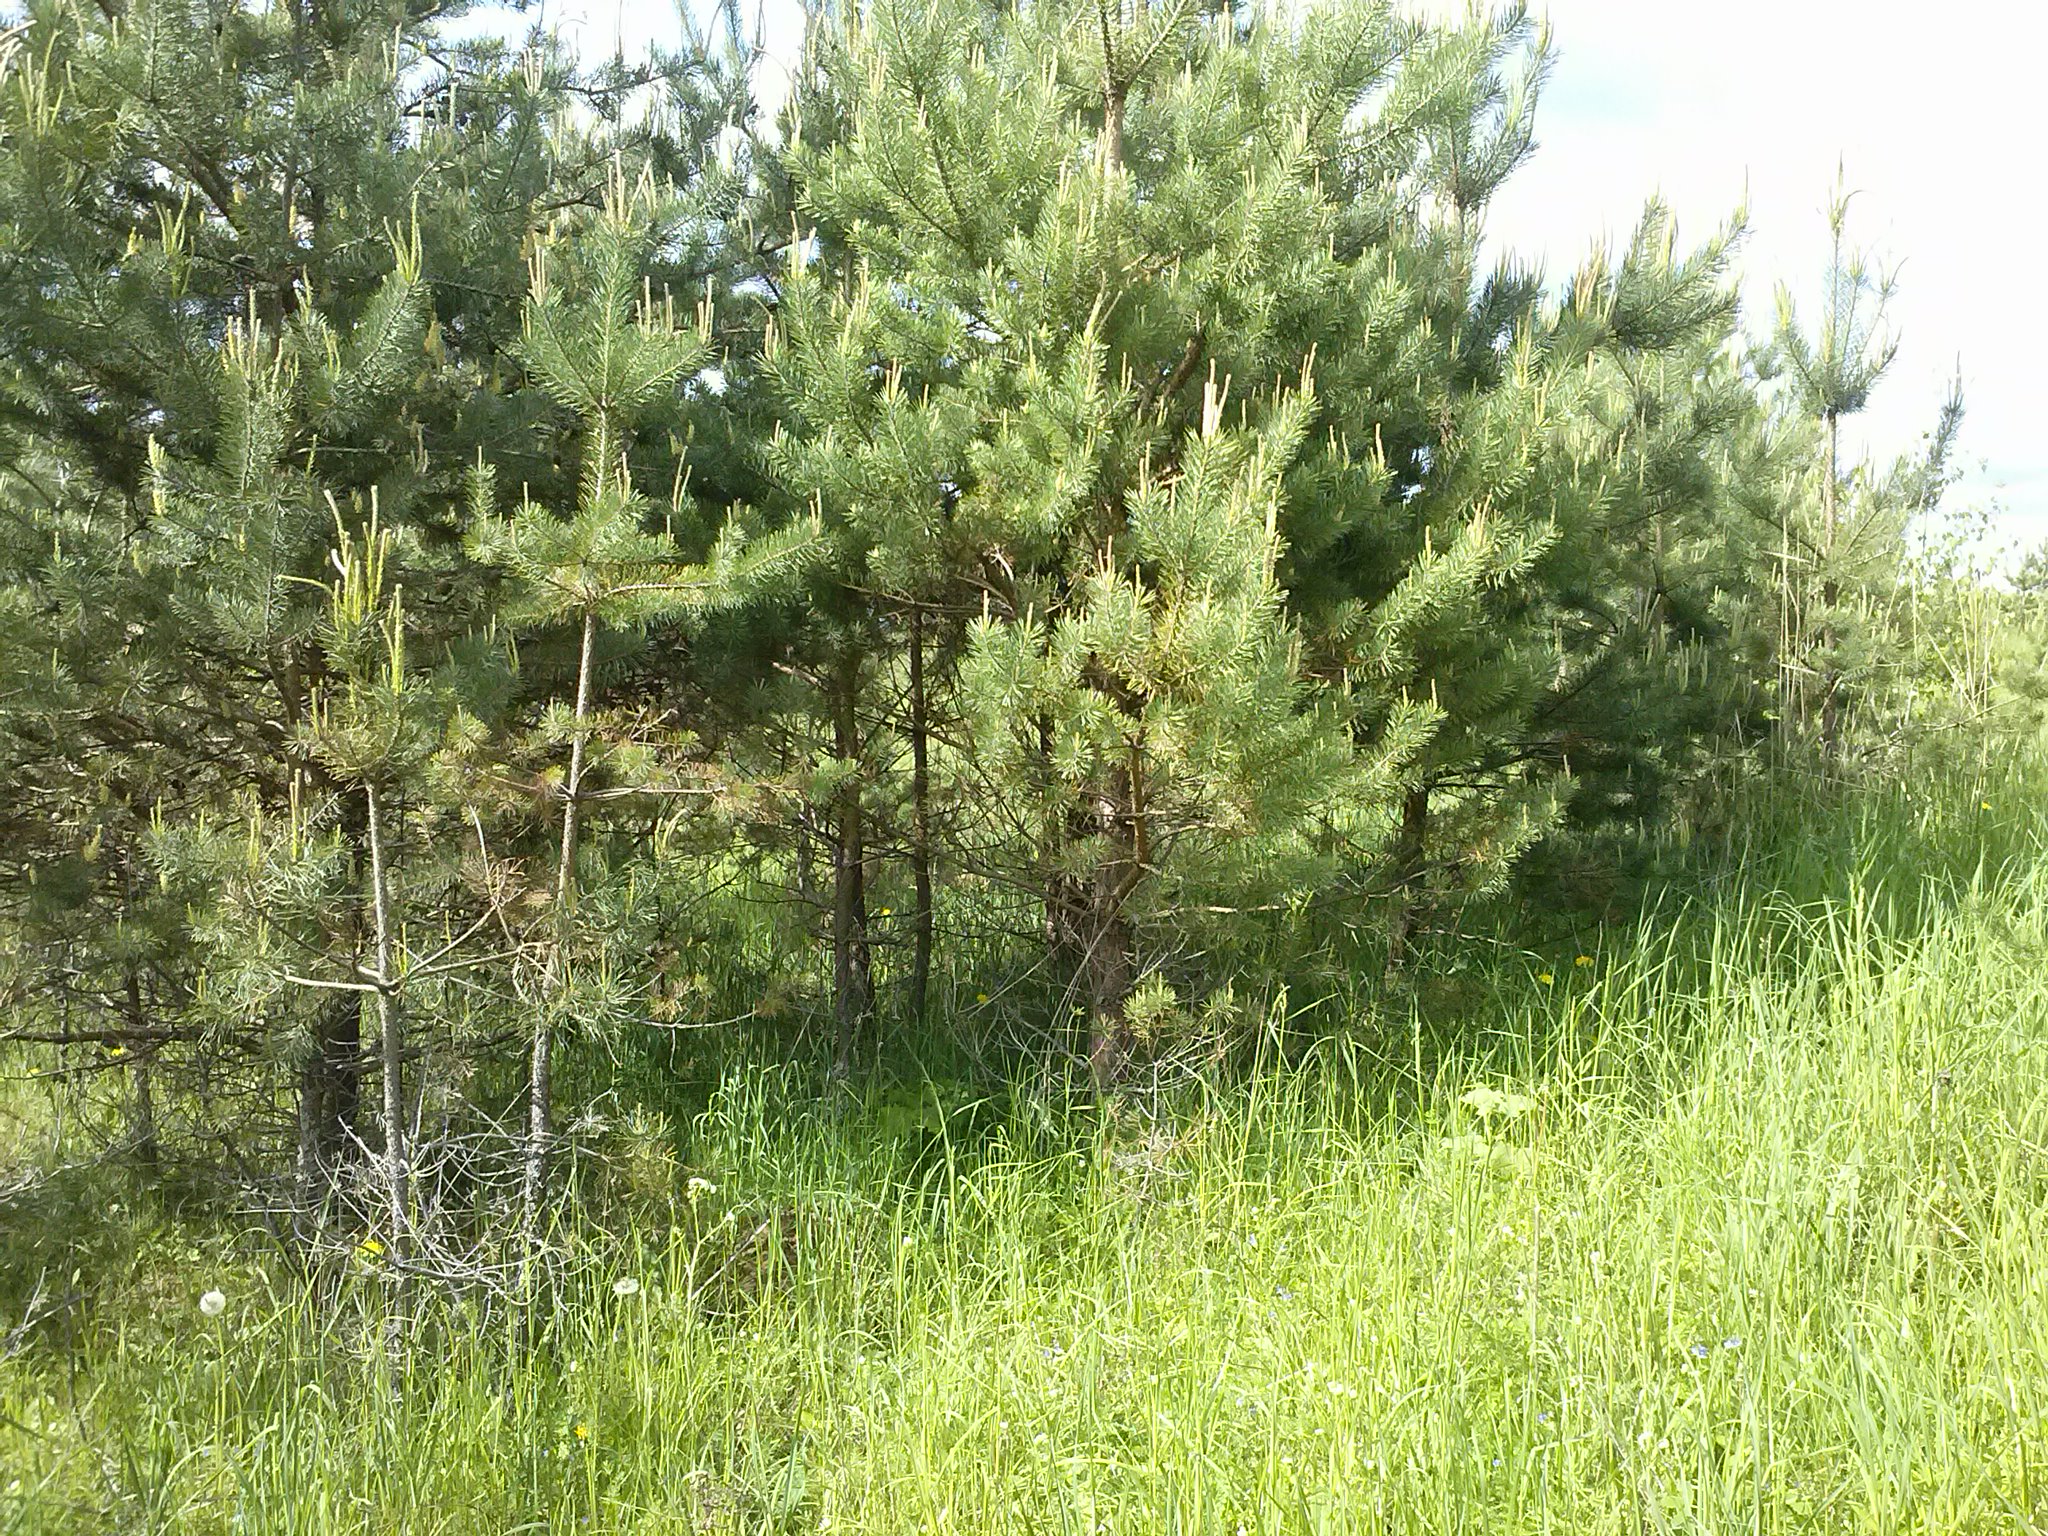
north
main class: Woodland
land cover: Pine dominated mixed woodland
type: hemiboreal forest and nemoral coniferous forest and mixed broadleaved-coniferous forest
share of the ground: > 75 %
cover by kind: coniferous forest trees 55 %, broadleaved forest trees 45 %
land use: Forestry
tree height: > 5 m
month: May
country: LV
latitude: 56.2528
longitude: 27.8333
